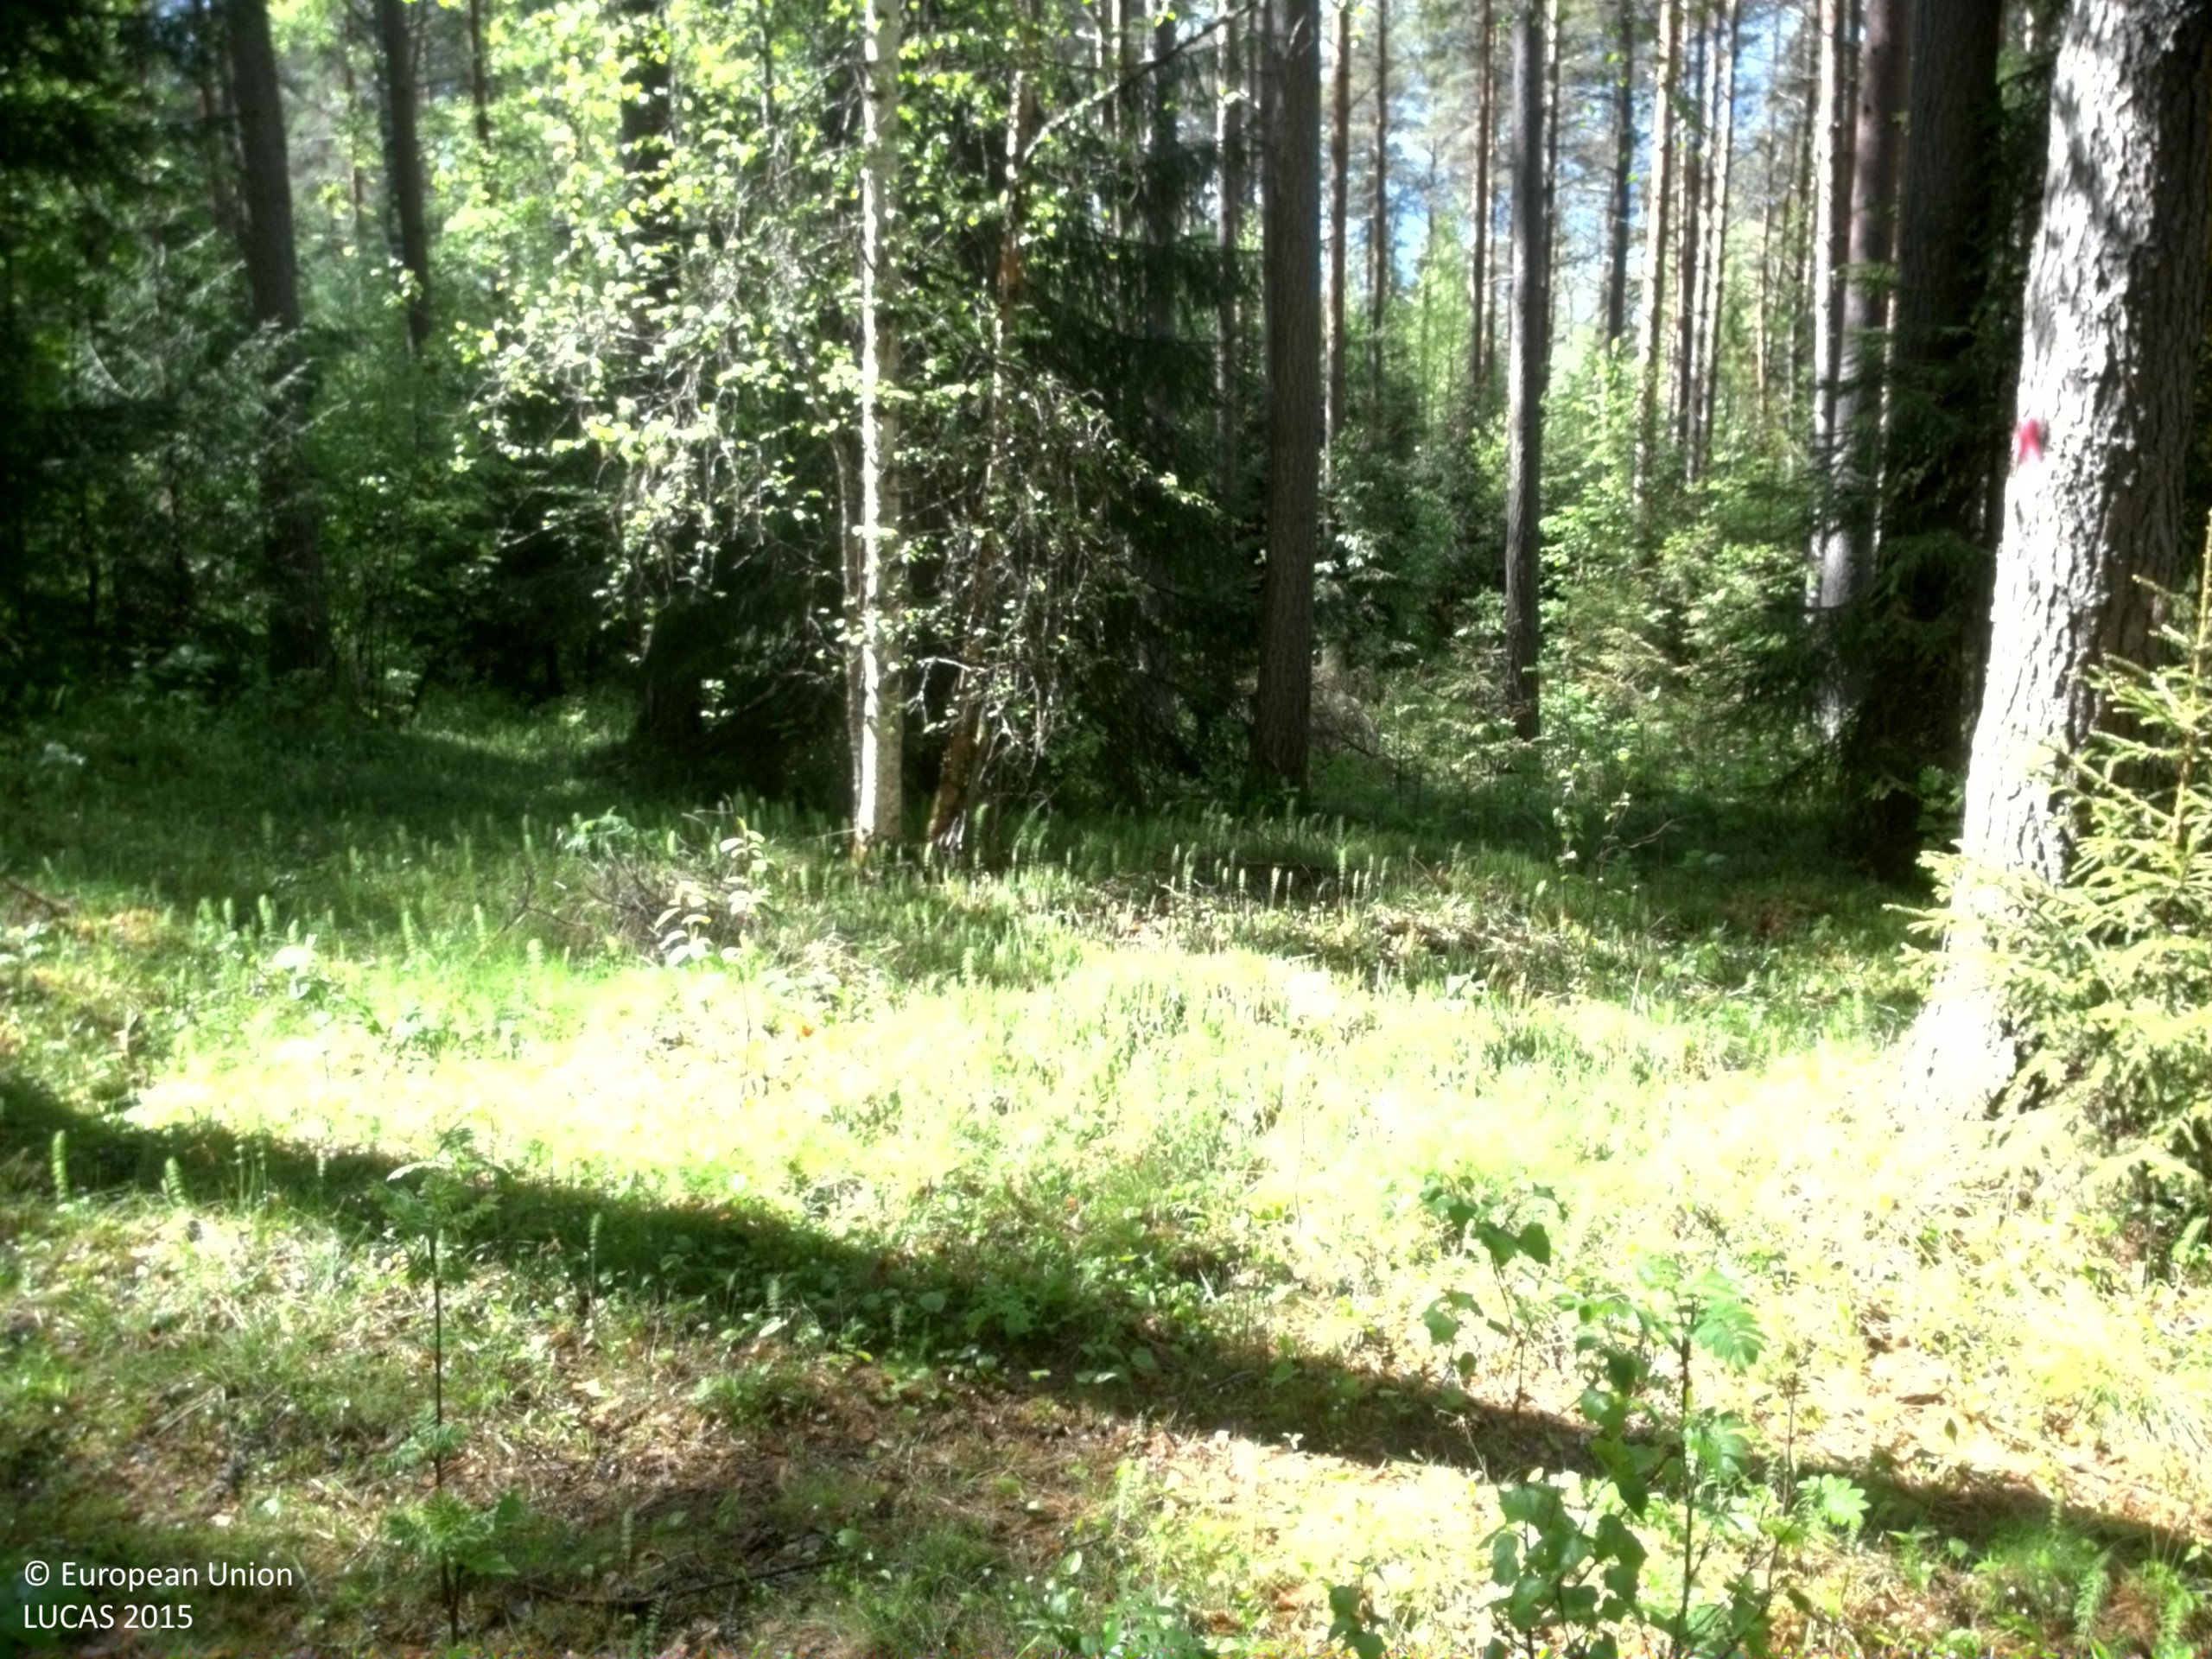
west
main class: Woodland
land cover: Pine dominated mixed woodland
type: boreal forest
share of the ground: 50 - 75 %
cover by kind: coniferous forest trees 40 %, broadleaved forest trees 20 %, shrubs 20 %, herbaceous plants 20 %
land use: Forestry
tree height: > 5 m
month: June
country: SE
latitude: 63.1563
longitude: 17.3800
